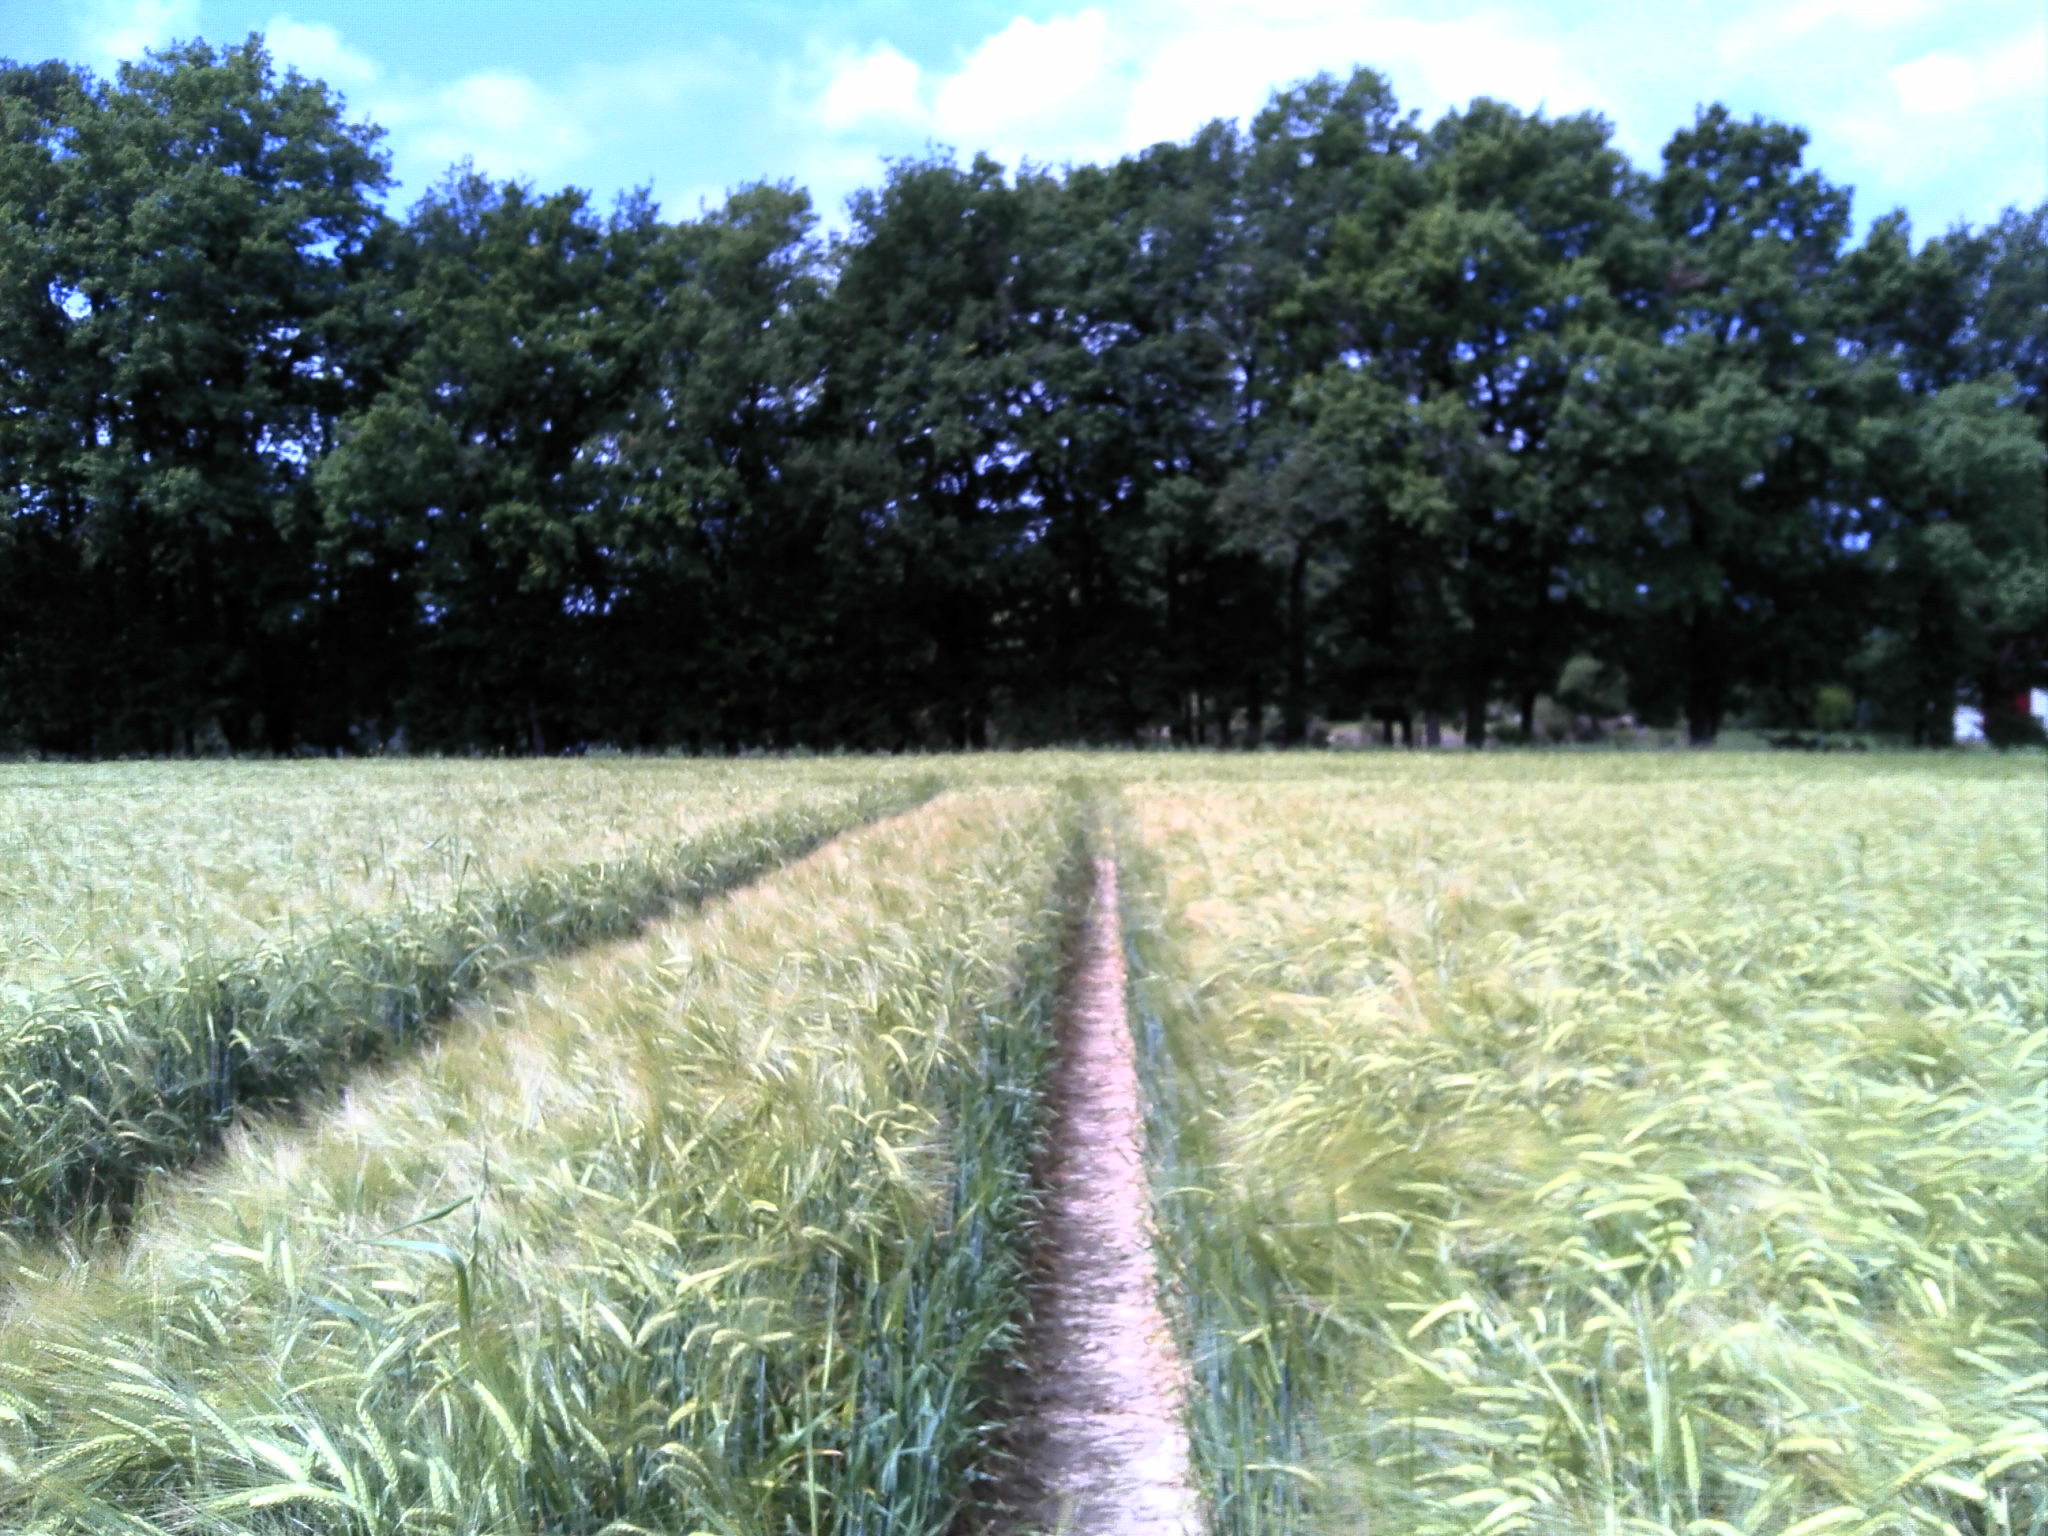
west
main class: Cropland
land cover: Barley
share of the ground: > 75 %
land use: Agriculture (excluding fallow land and kitchen gardens)
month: May
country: FR
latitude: 46.5815
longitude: 1.5990
